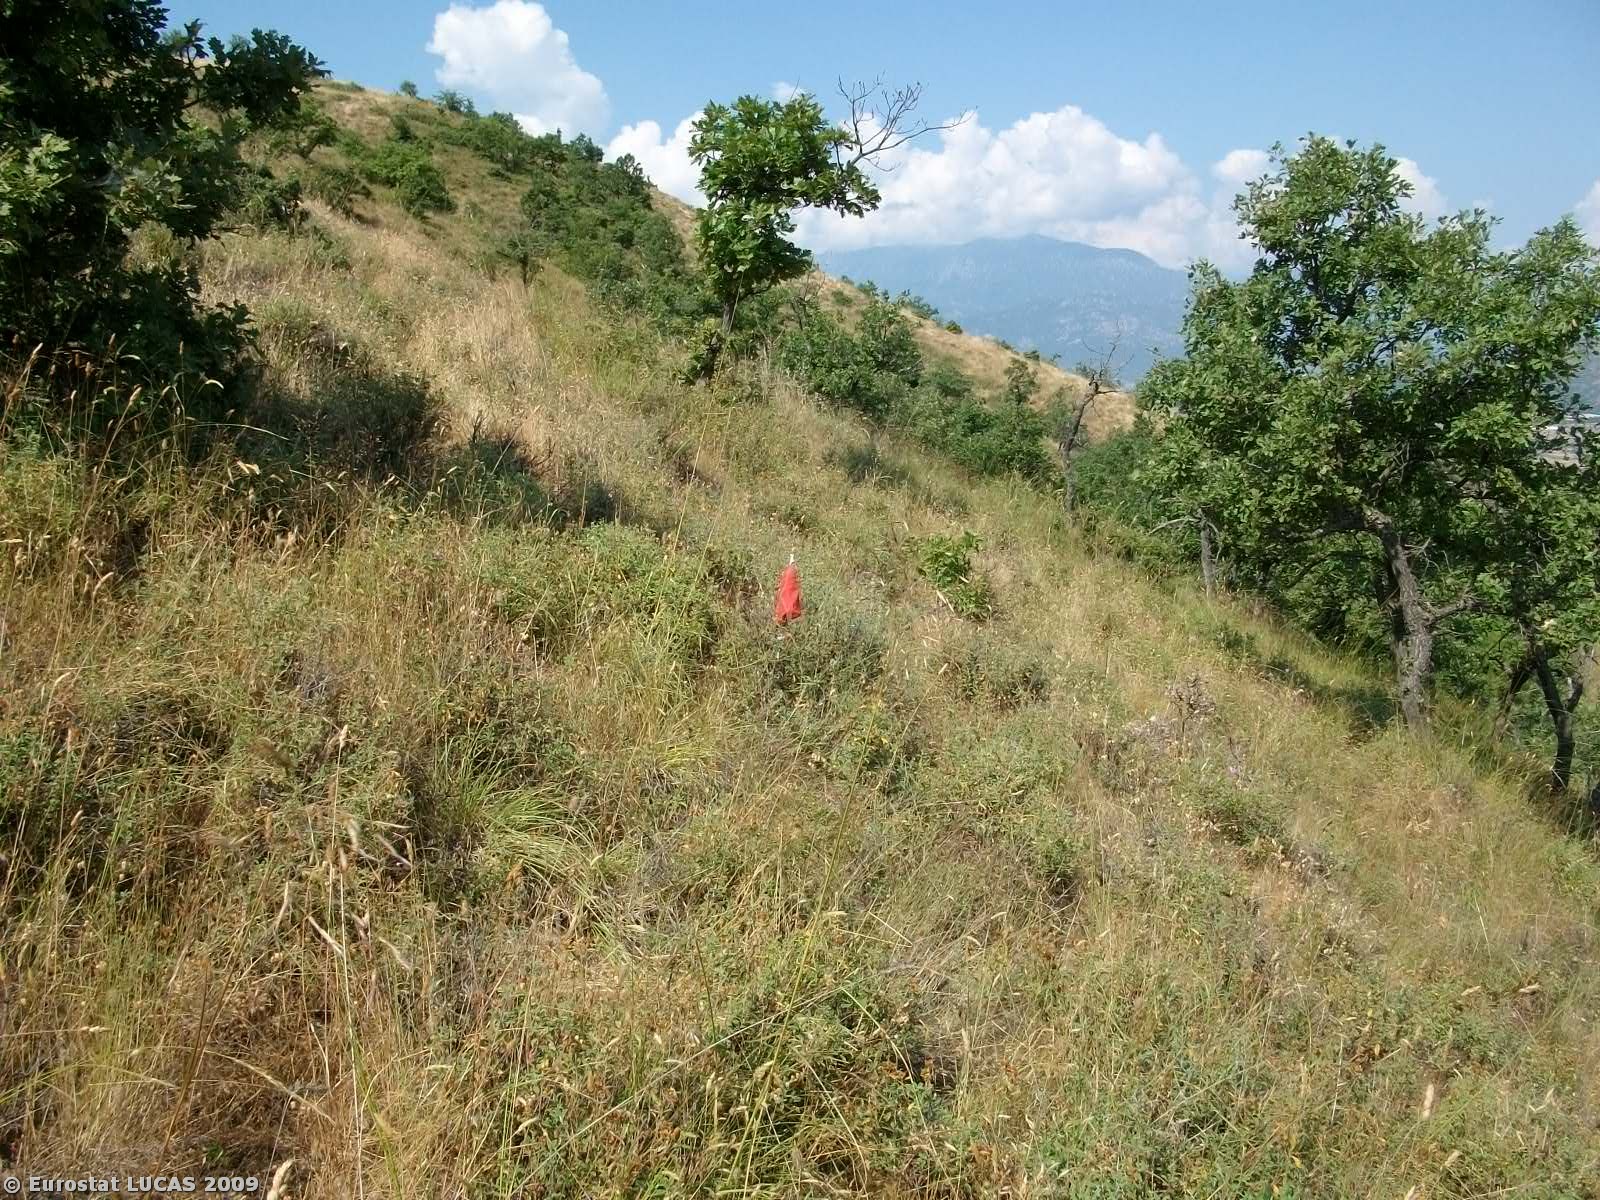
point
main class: Grassland
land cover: Grassland with sparse tree/shrub cover
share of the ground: > 75 %
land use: Agriculture (excluding fallow land and kitchen gardens)
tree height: < 5 m
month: July
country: GR
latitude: 39.6893
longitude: 21.7268
